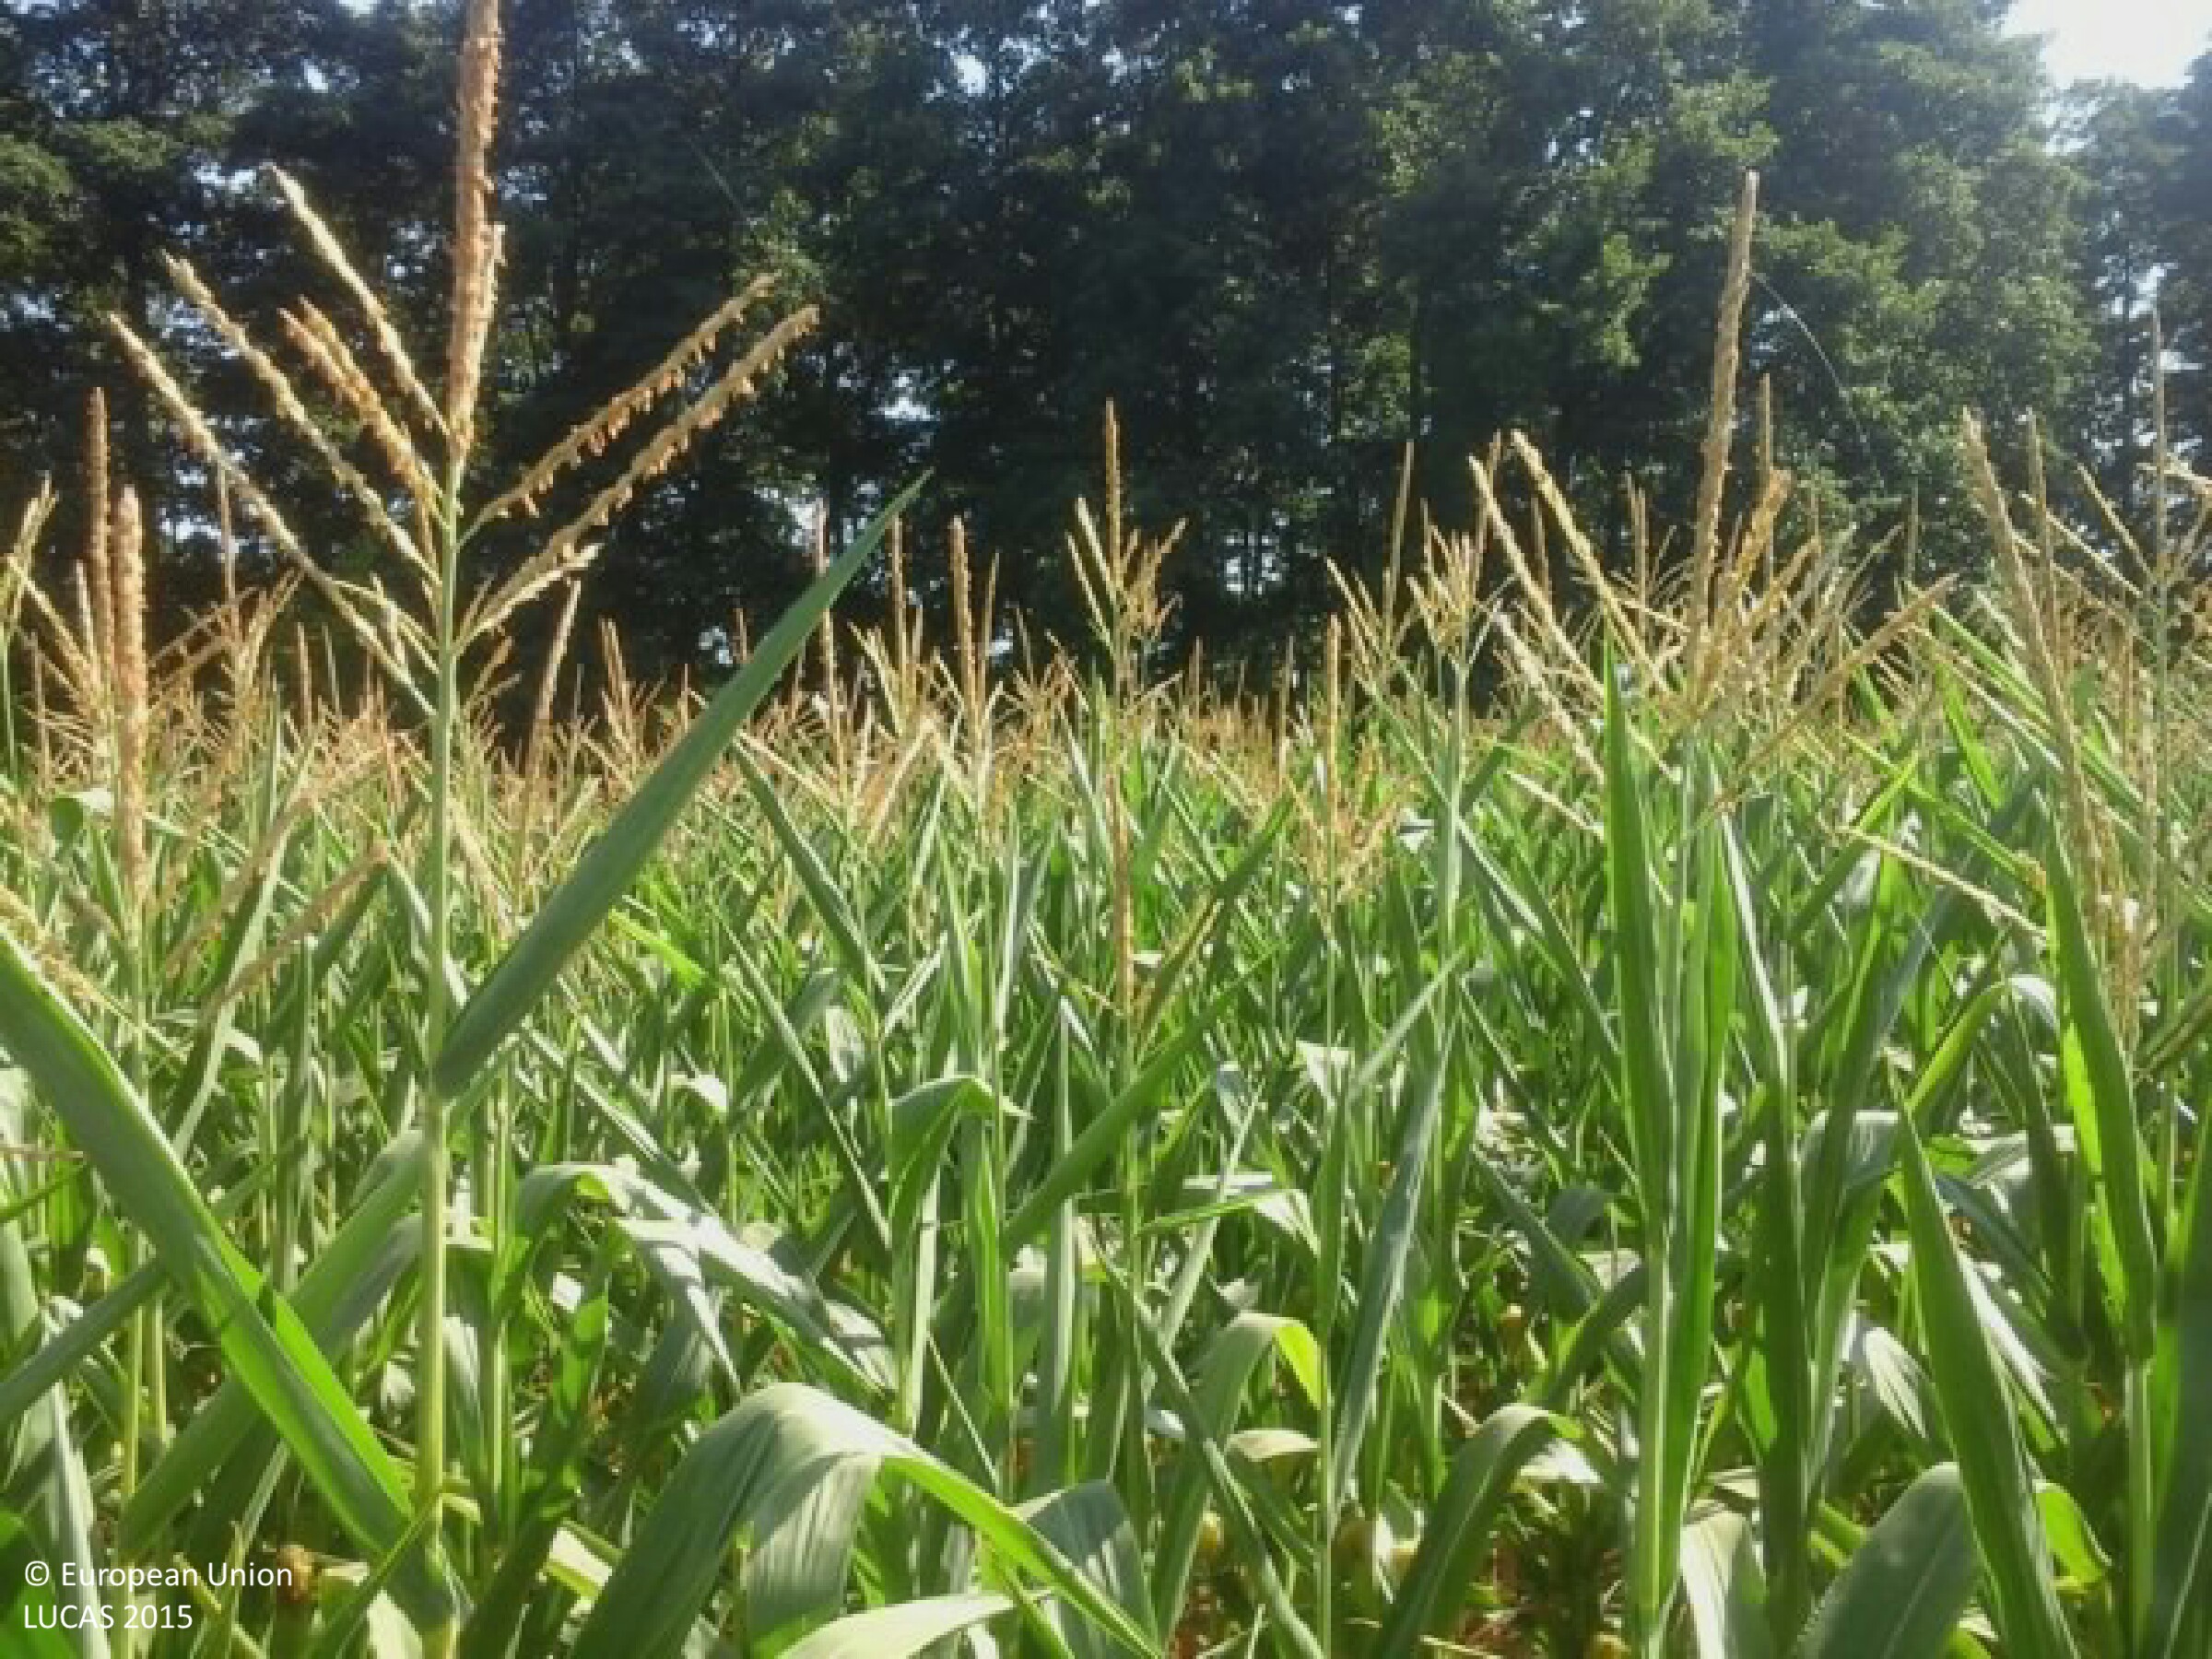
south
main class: Cropland
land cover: Maize
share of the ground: > 75 %
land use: Agriculture (excluding fallow land and kitchen gardens)
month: July
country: HU
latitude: 46.2385
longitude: 17.1481
